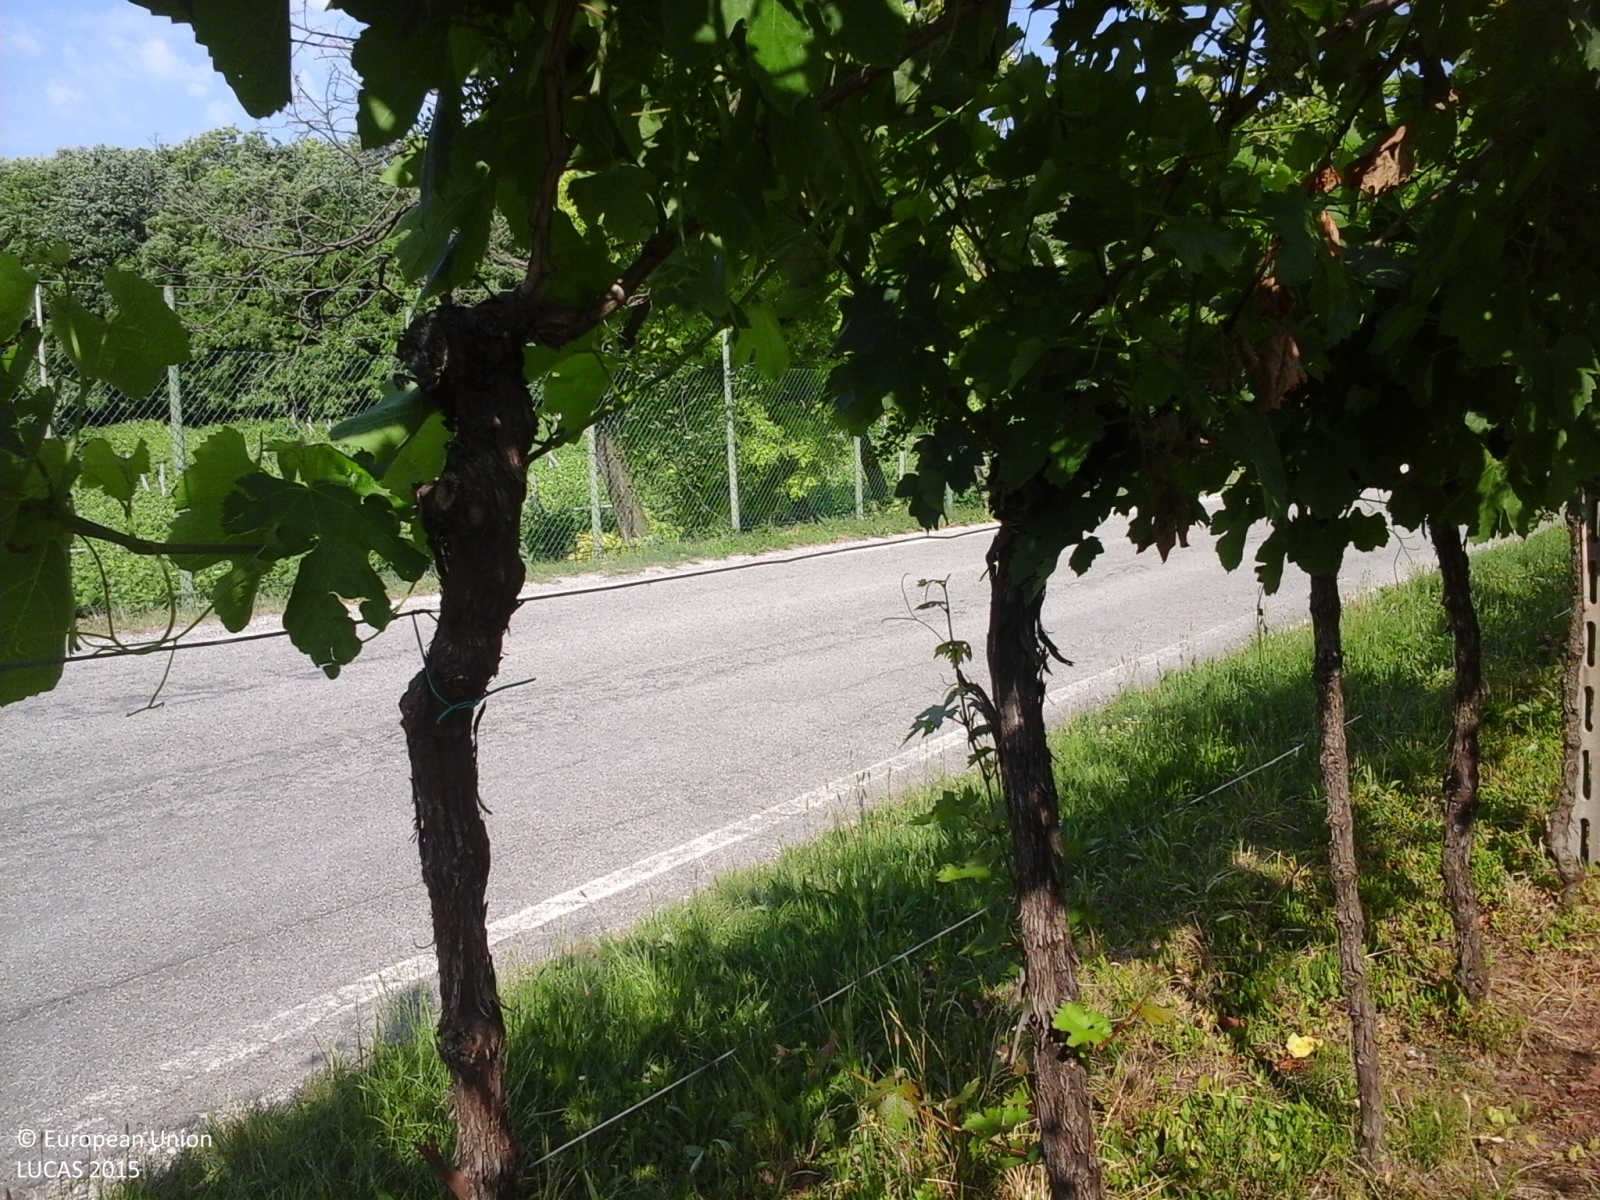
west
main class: Cropland
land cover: Vineyards
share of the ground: > 75 %
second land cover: Grassland without tree/shrub cover
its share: > 75 %
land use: Agriculture (excluding fallow land and kitchen gardens)
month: June
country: IT
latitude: 45.5378
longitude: 10.7543
